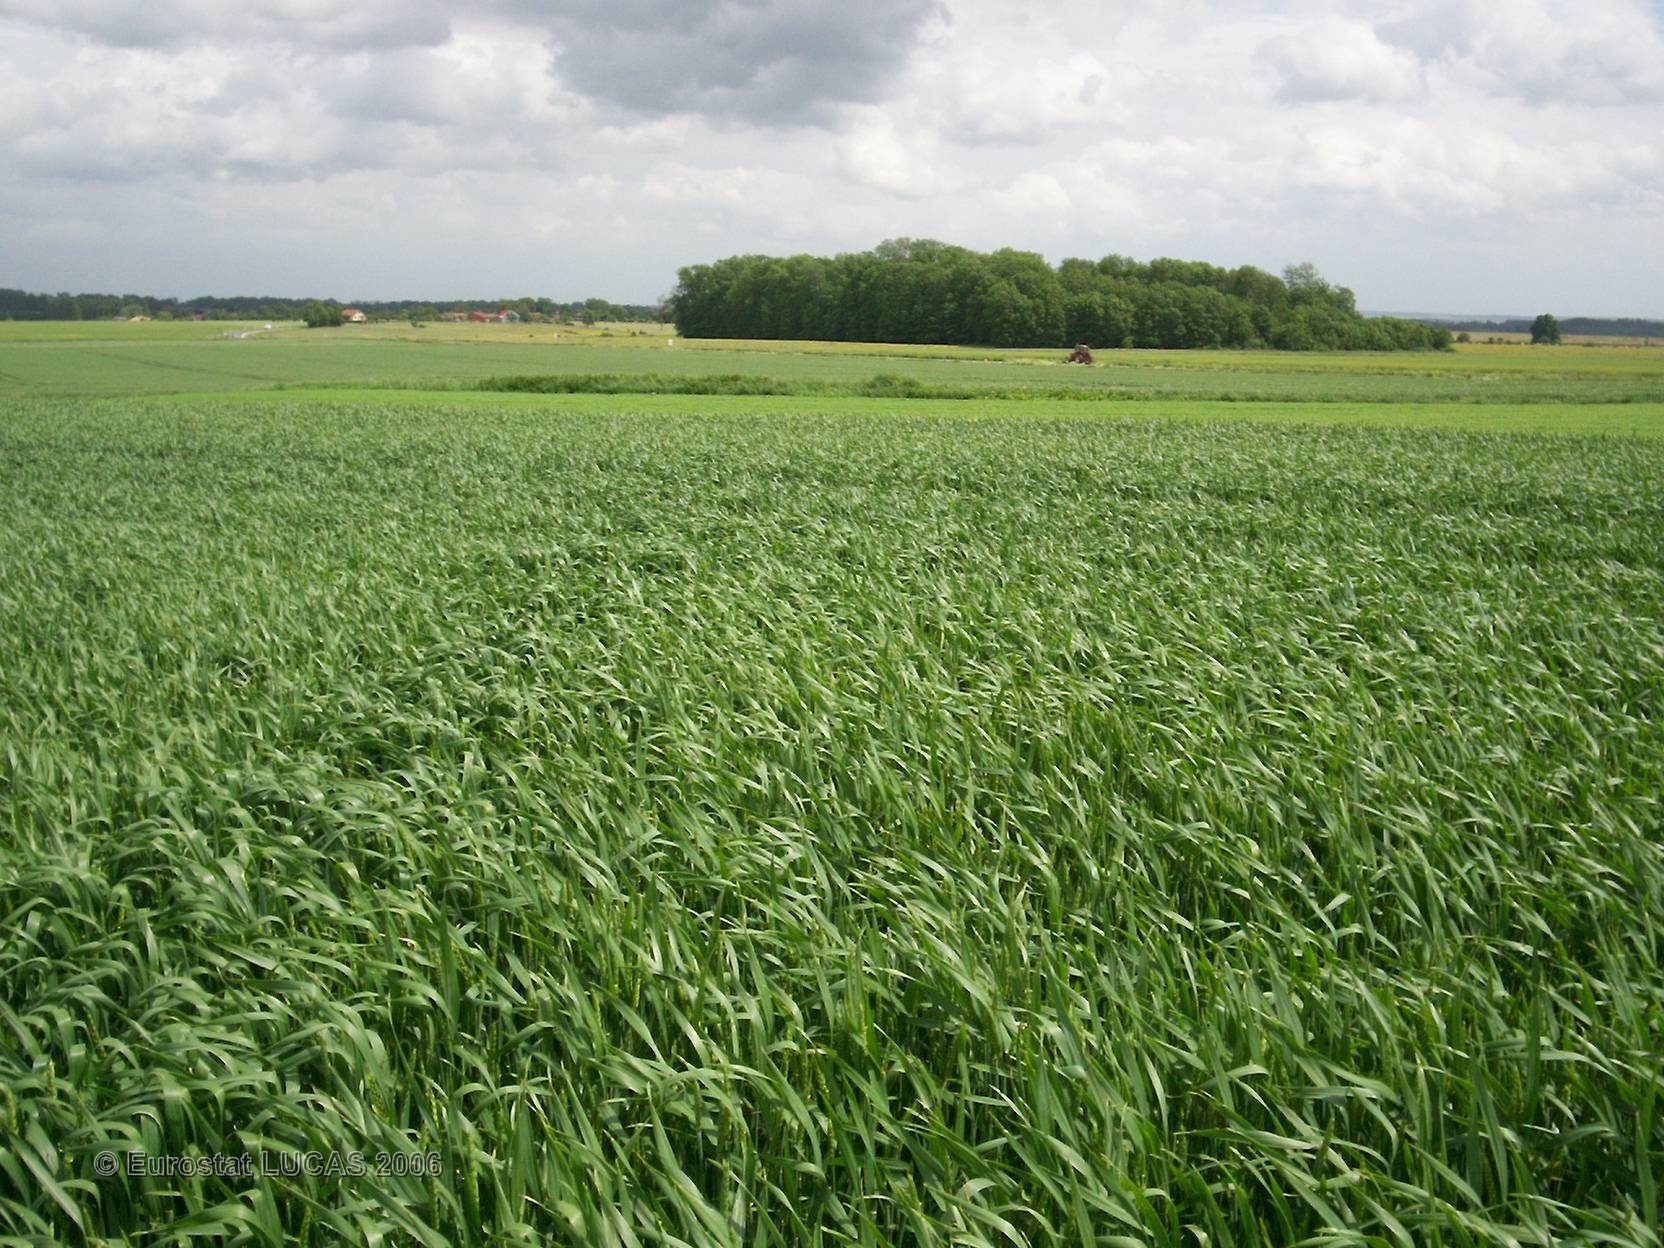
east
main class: Cropland
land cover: Common wheat
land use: Agriculture (excluding fallow land and kitchen gardens)
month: May
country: FR
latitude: 48.3557
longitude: 4.4777
